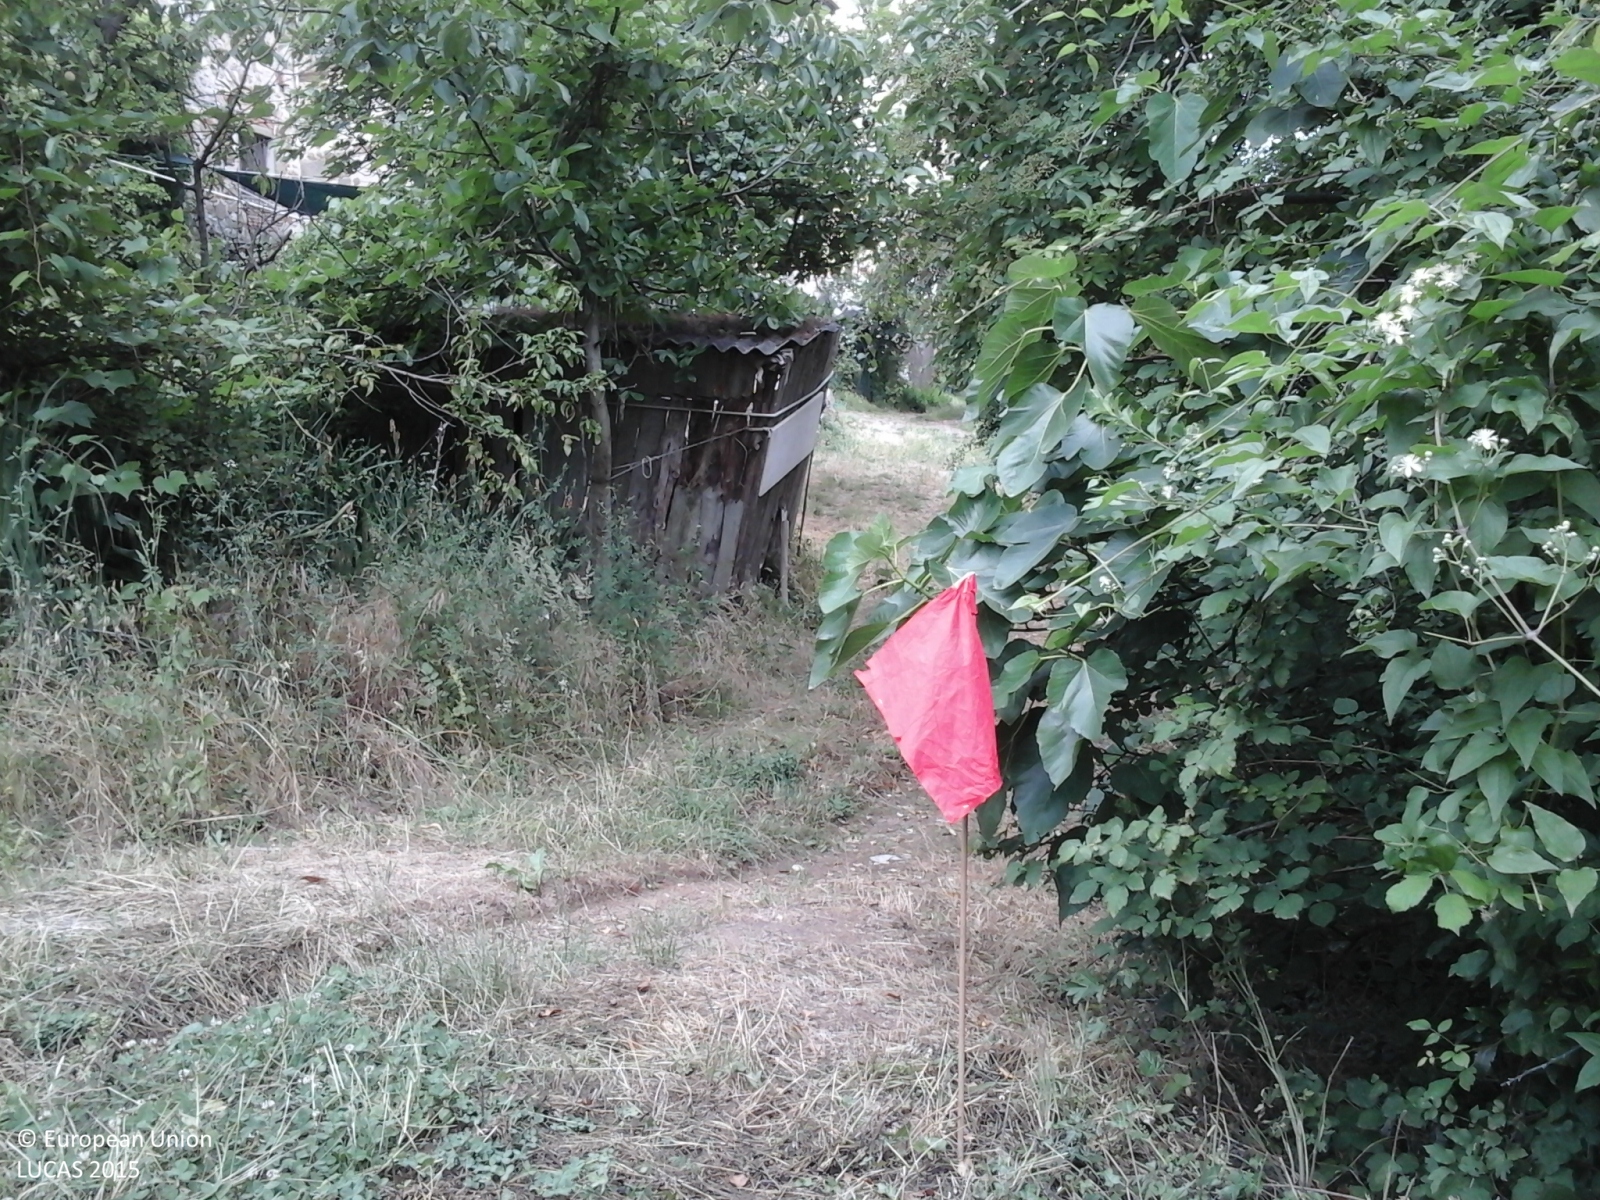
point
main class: Artificial land
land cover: Non built-up linear features
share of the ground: > 75 %
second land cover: Grassland without tree/shrub cover
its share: > 75 %
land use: Road transport
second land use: Agriculture (excluding fallow land and kitchen gardens)
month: June
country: IT
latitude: 43.8356
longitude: 11.4266
